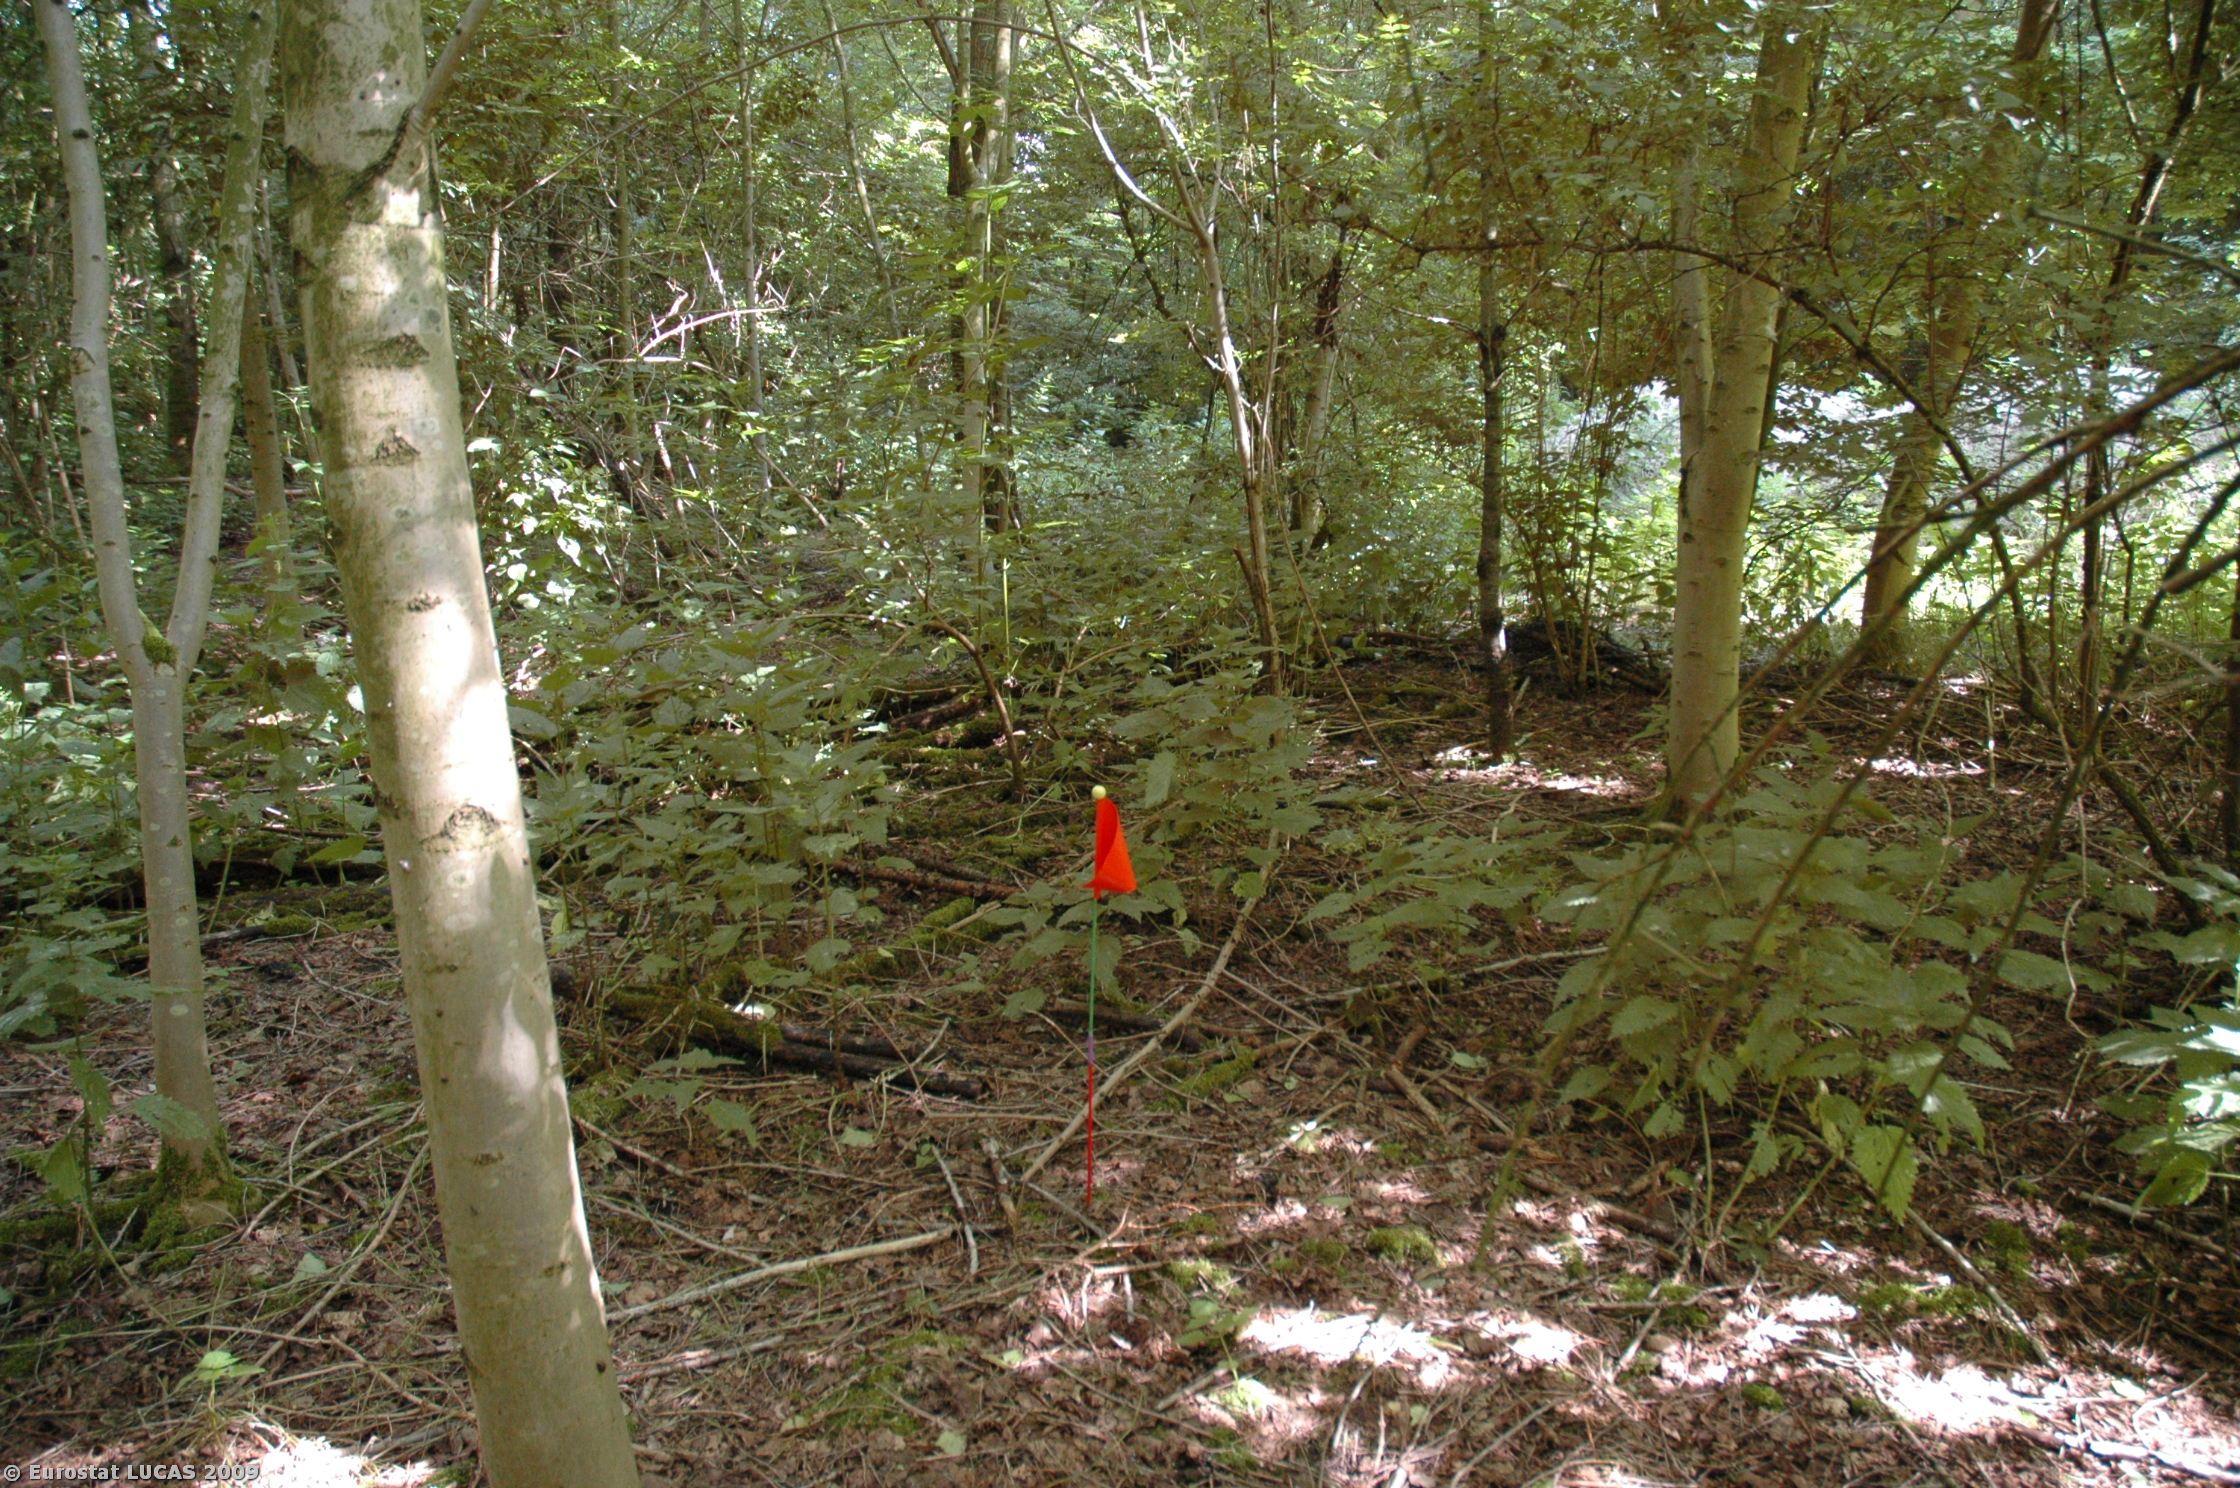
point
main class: Woodland
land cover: Broadleaved woodland
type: plantations and self-sown exotic forest
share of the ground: > 75 %
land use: Nature reserves
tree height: > 5 m
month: June
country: NL
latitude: 52.3738
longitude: 5.2829
